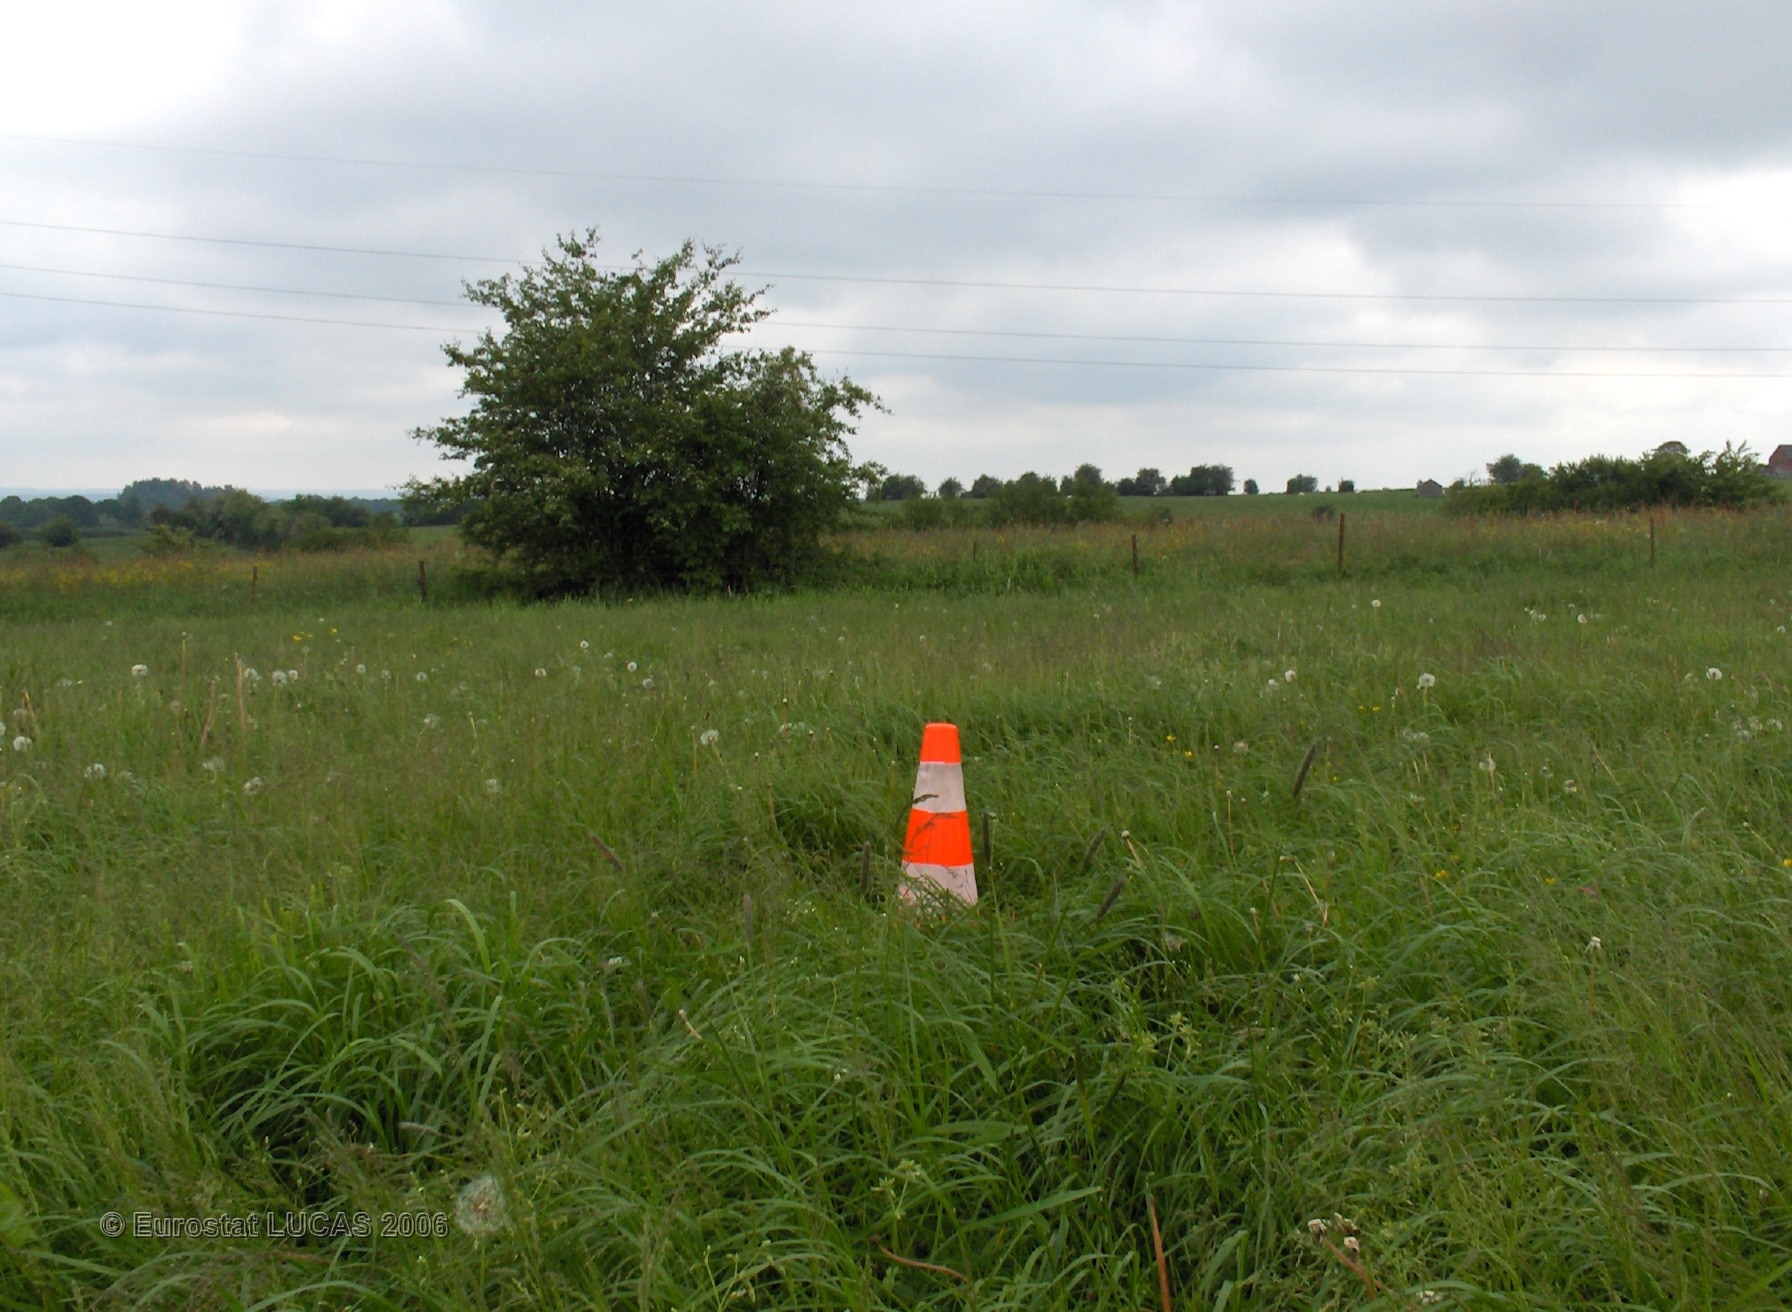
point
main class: Grassland
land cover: Grassland without tree/shrub cover
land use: Agriculture (excluding fallow land and kitchen gardens)
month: June
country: BE
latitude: 50.2006
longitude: 4.6025
